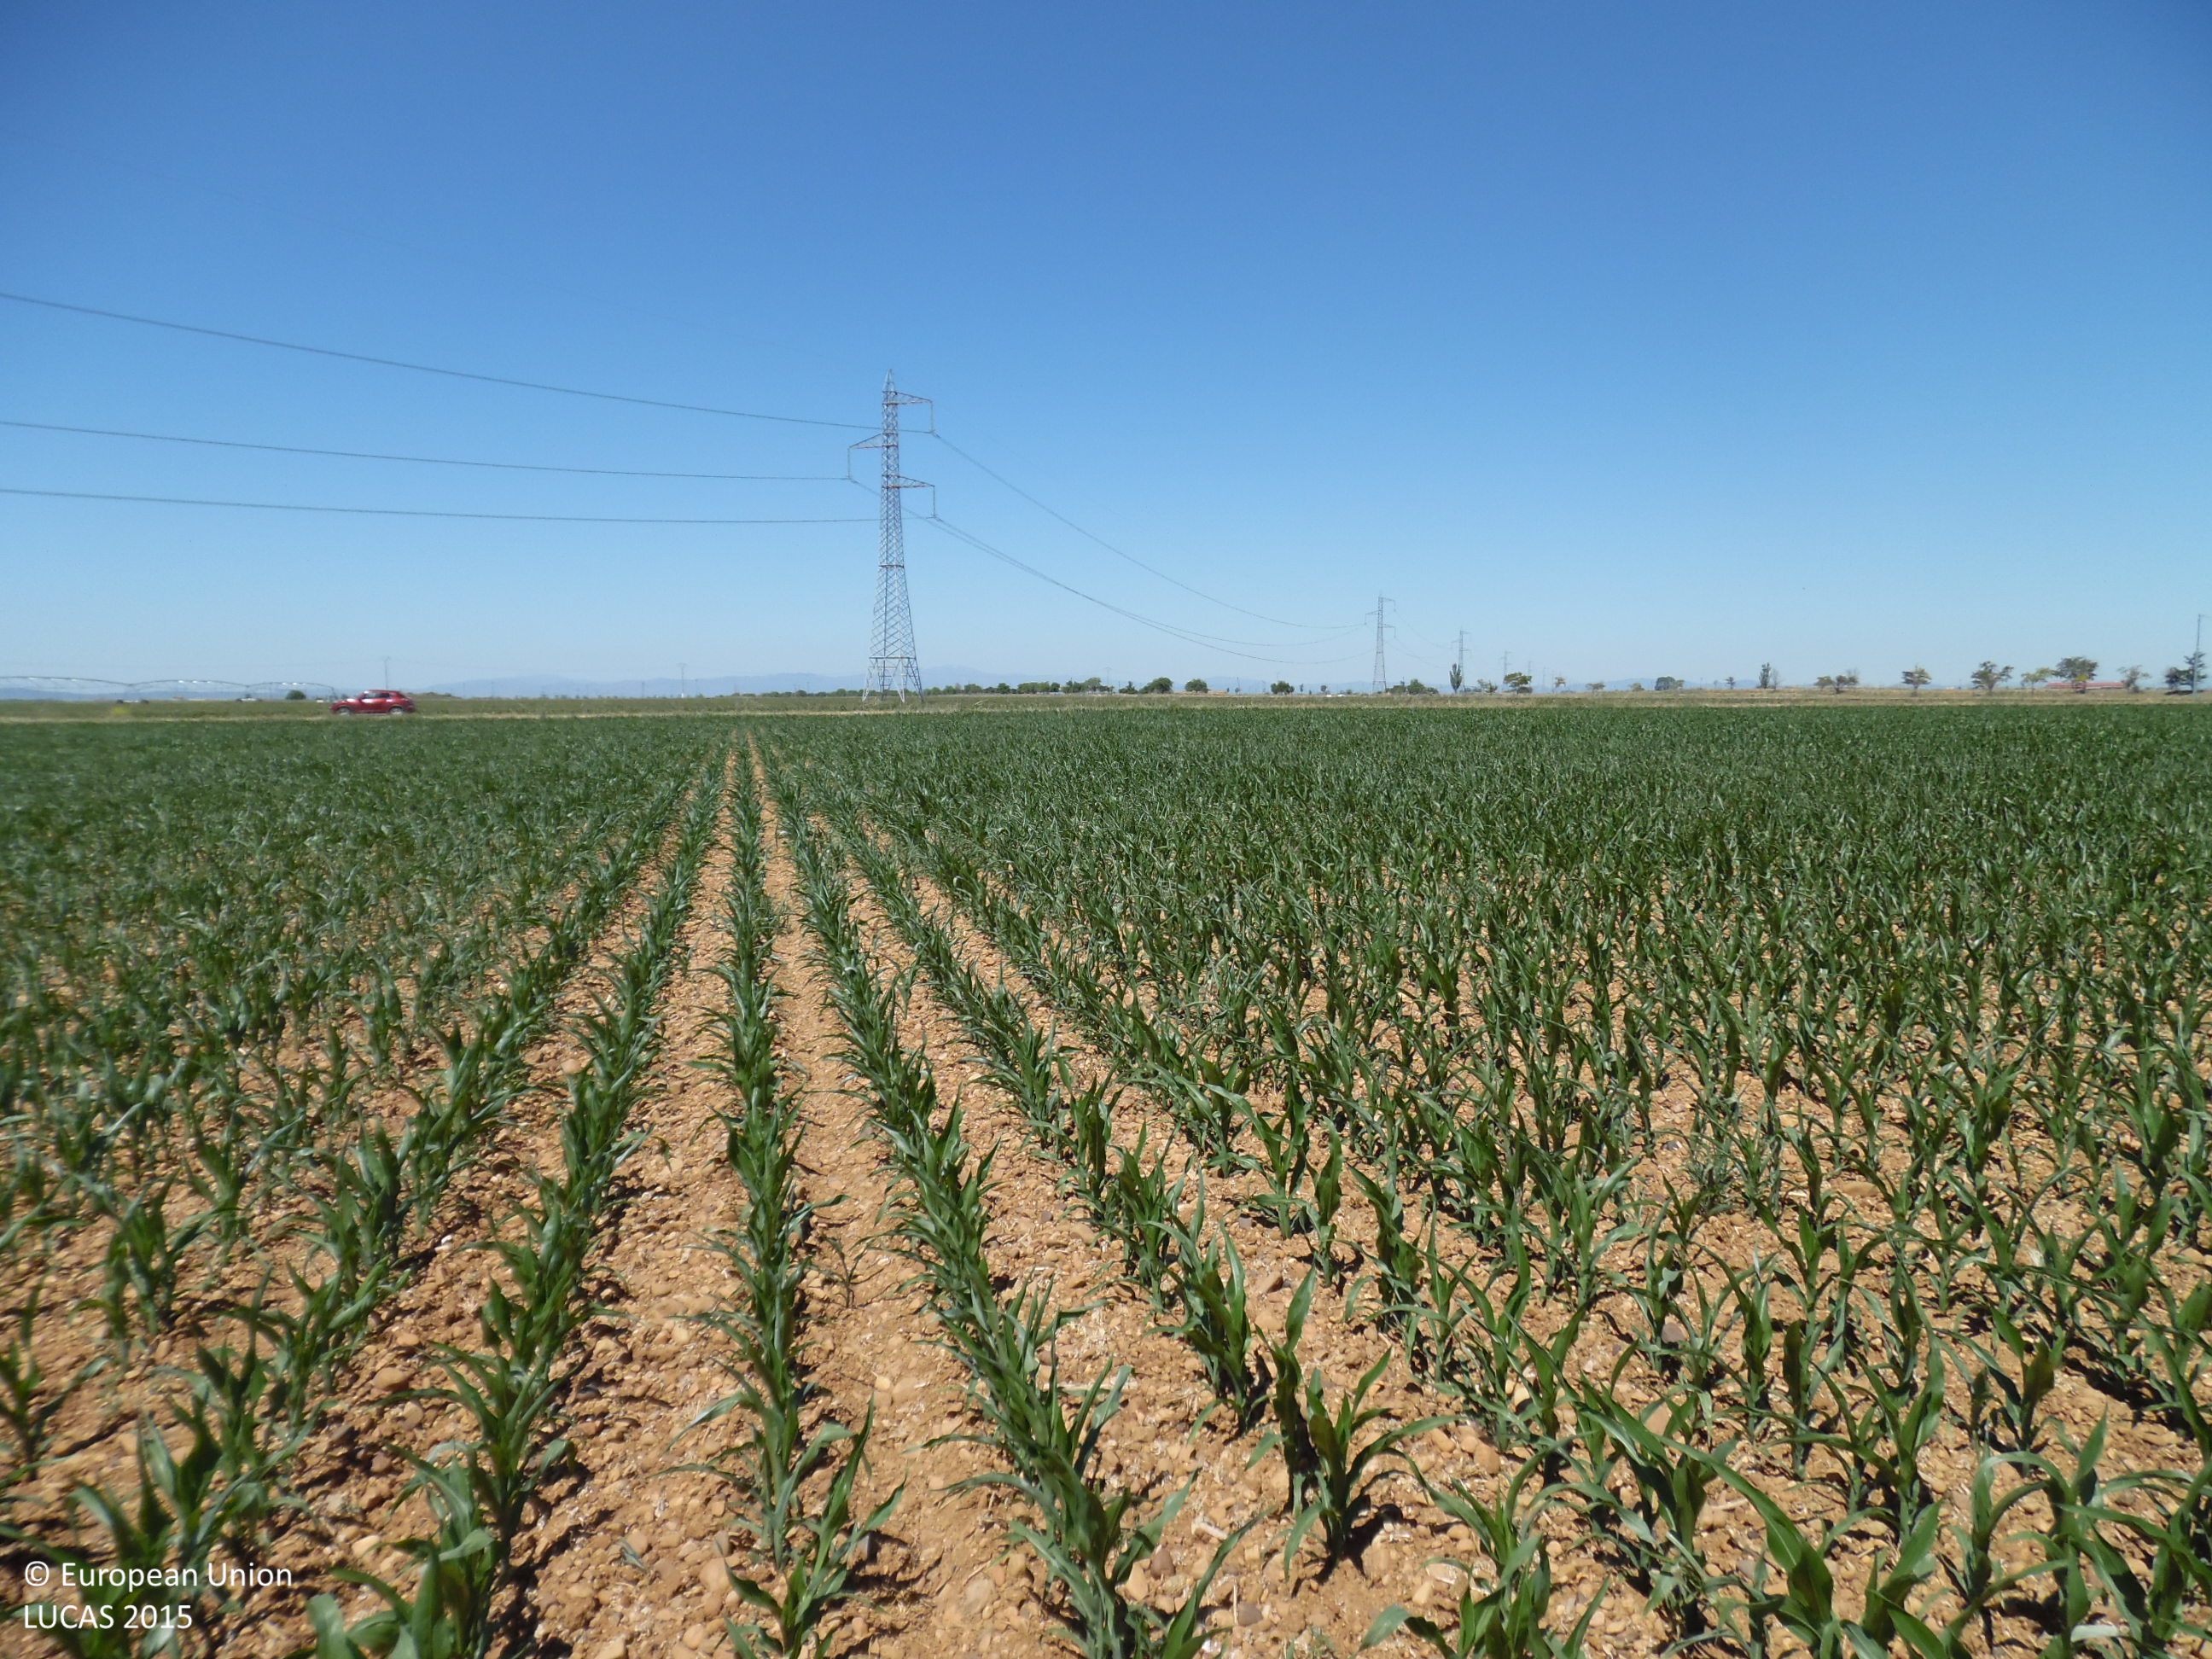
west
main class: Cropland
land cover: Maize
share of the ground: 25 - 50 %
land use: Agriculture (excluding fallow land and kitchen gardens)
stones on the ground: < 10 %
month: June
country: ES
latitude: 42.3223
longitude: -5.6886
